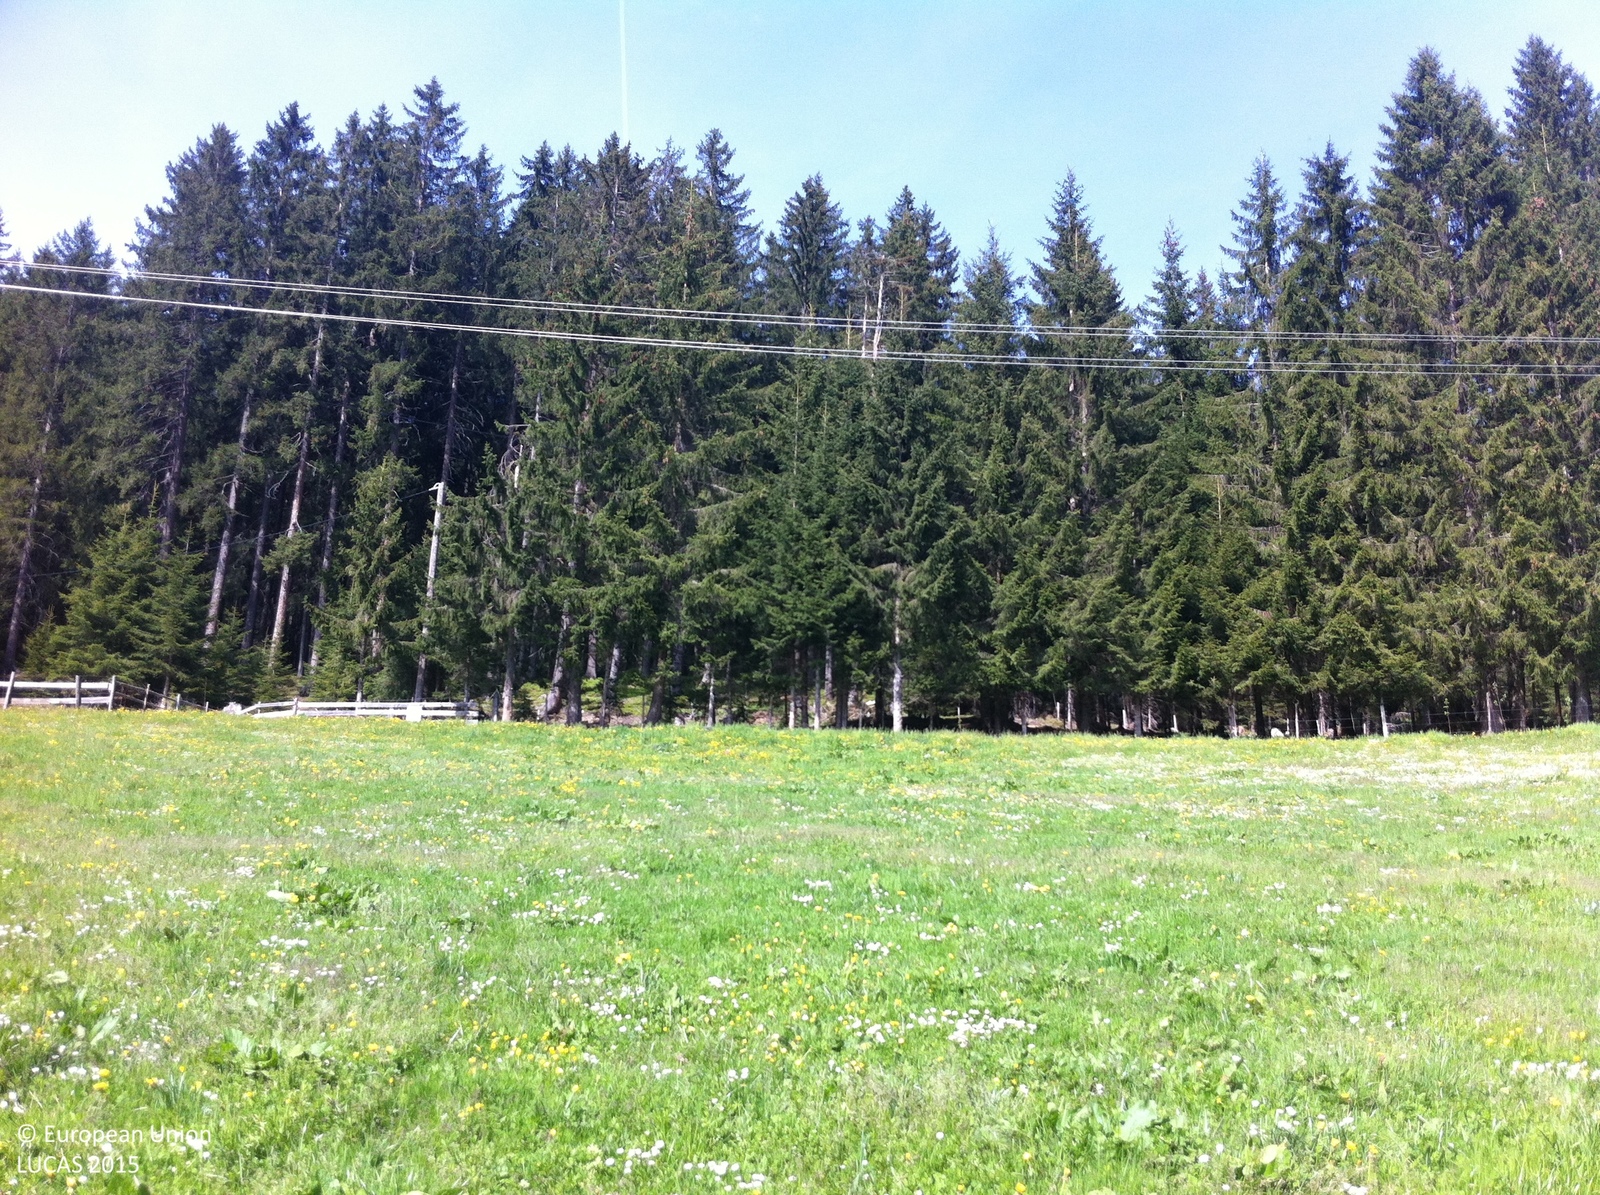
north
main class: Grassland
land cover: Grassland without tree/shrub cover
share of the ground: > 75 %
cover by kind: herbaceous plants 100 %
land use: Agriculture (excluding fallow land and kitchen gardens)
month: May
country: AT
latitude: 47.3098
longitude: 11.7313
